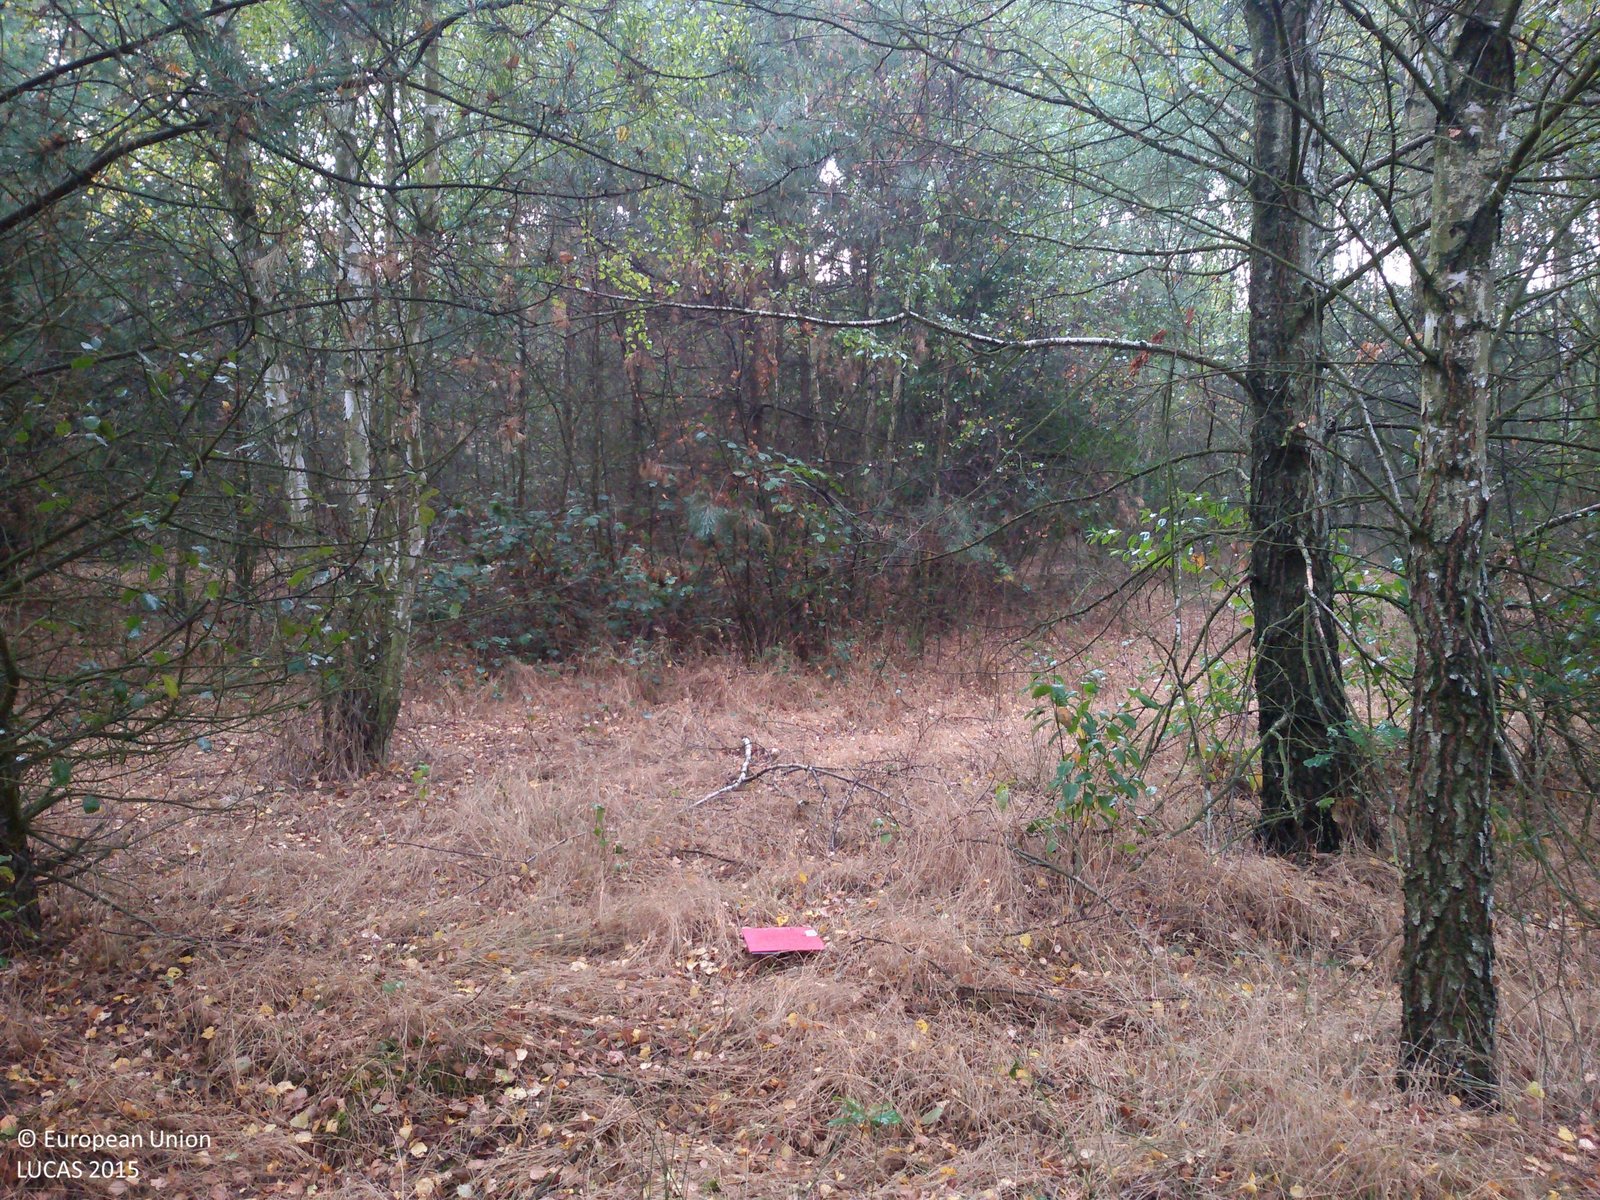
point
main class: Woodland
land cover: Broadleaved woodland
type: mesophytic deciduous forest
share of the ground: > 75 %
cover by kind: broadleaved forest trees 70 %, coniferous forest trees 15 %, herbaceous plants 15 %
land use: Forestry
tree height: > 5 m
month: September
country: PL
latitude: 51.3231
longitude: 18.8473
